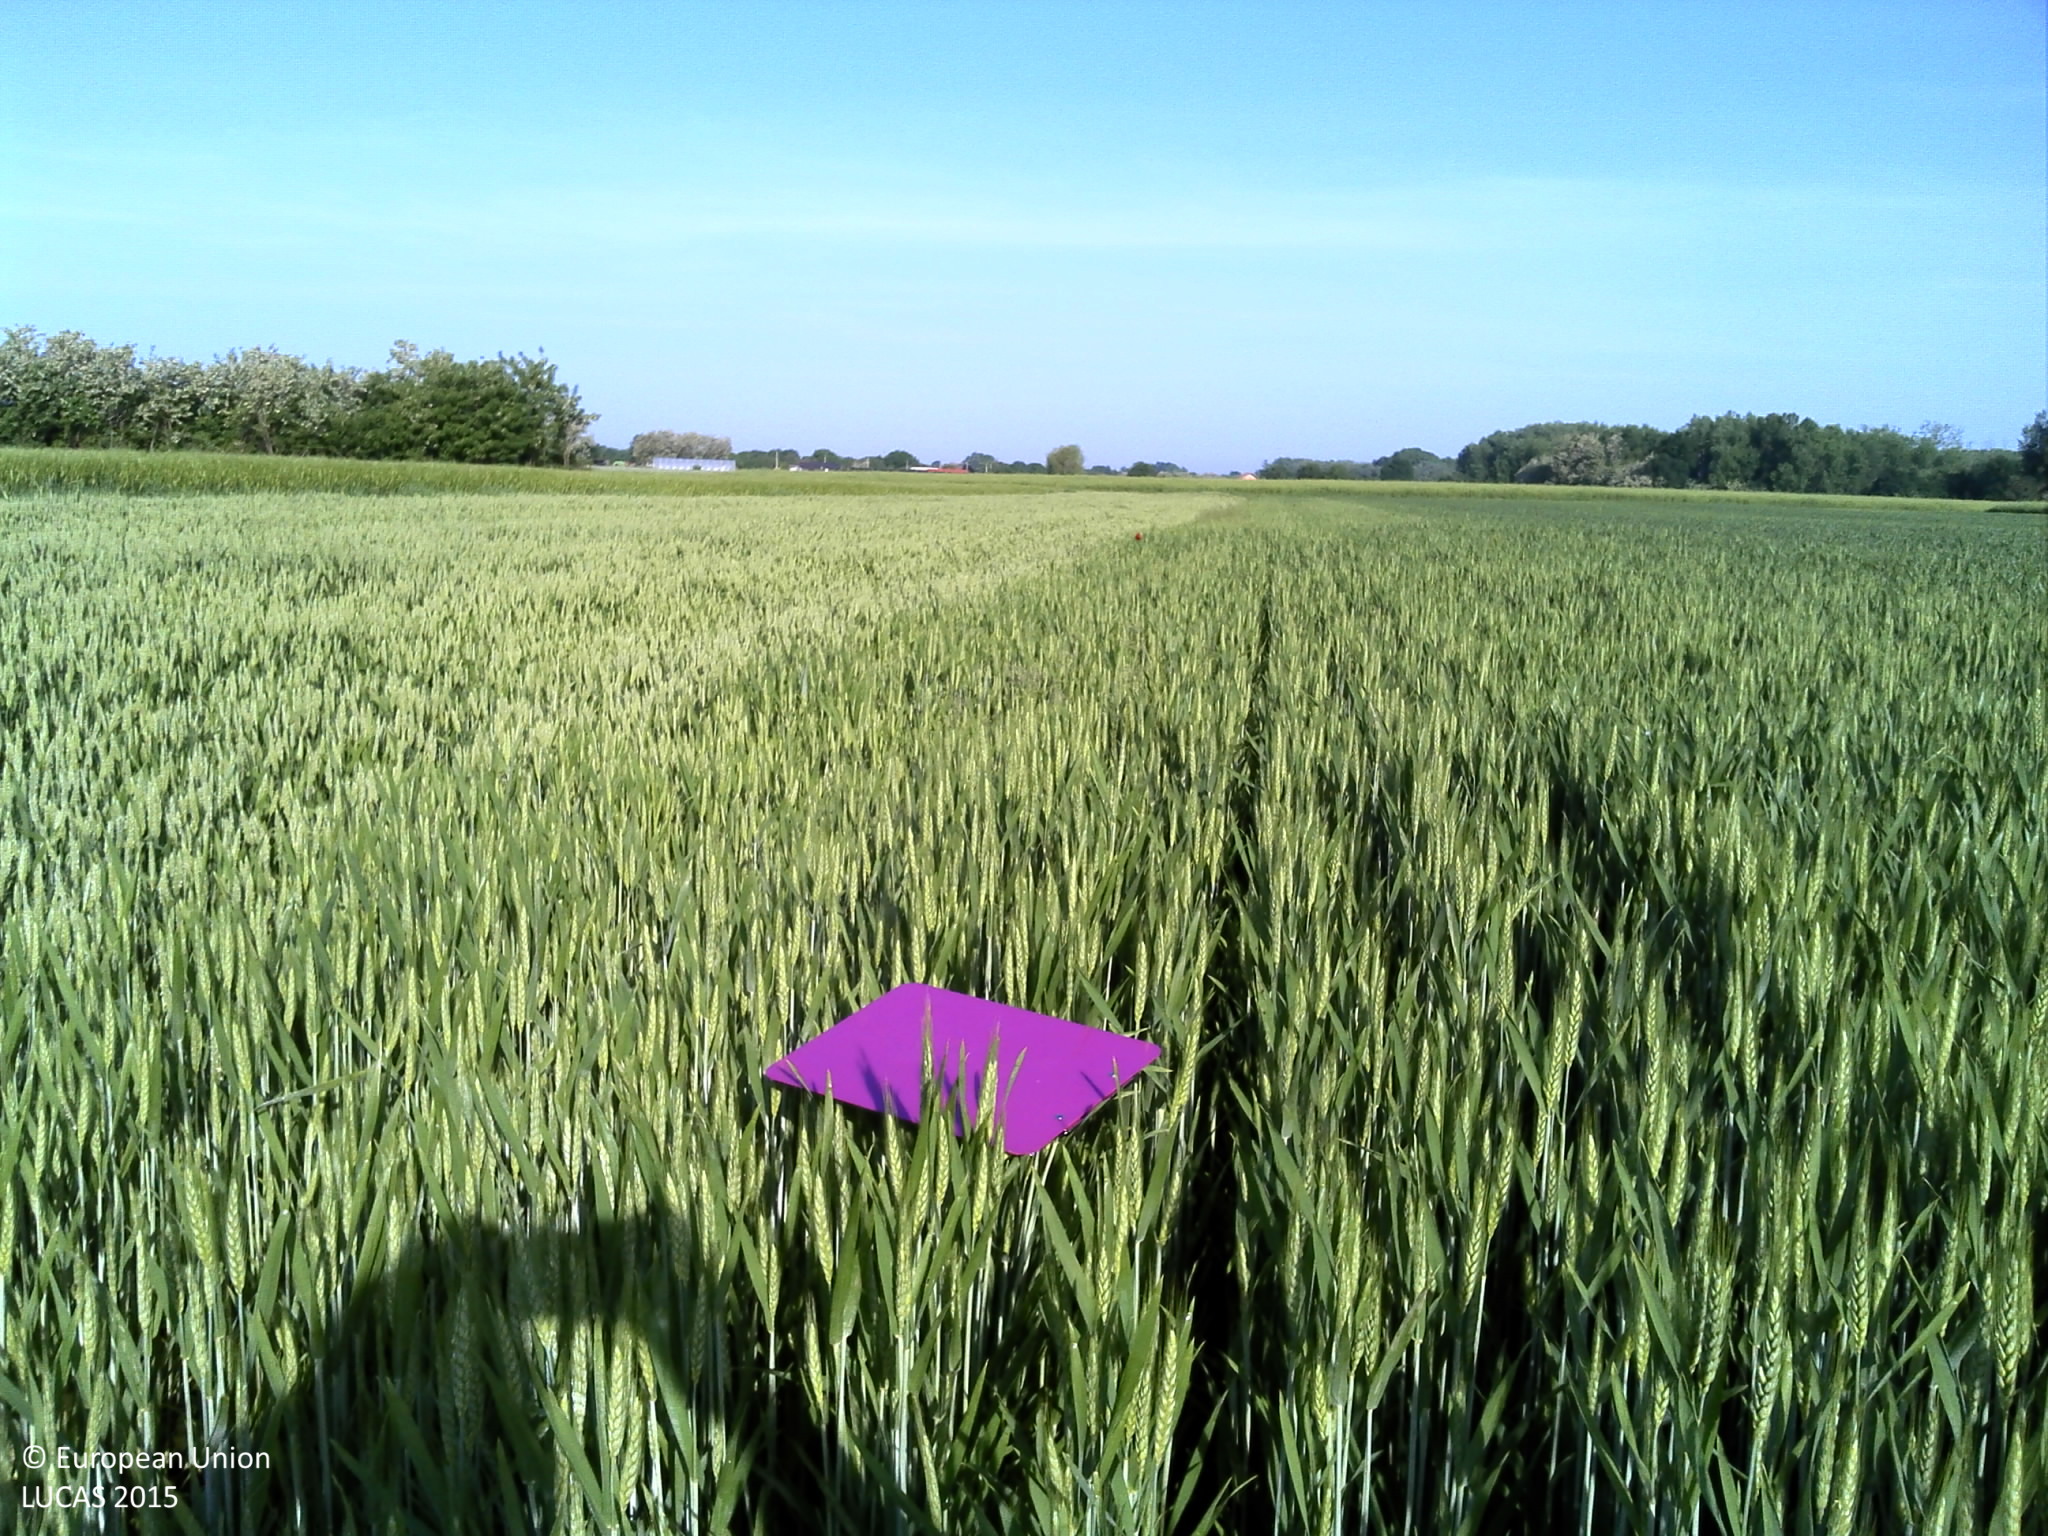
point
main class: Cropland
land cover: Common wheat
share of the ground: > 75 %
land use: Agriculture (excluding fallow land and kitchen gardens)
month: May
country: HR
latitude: 45.6133
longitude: 18.5088
